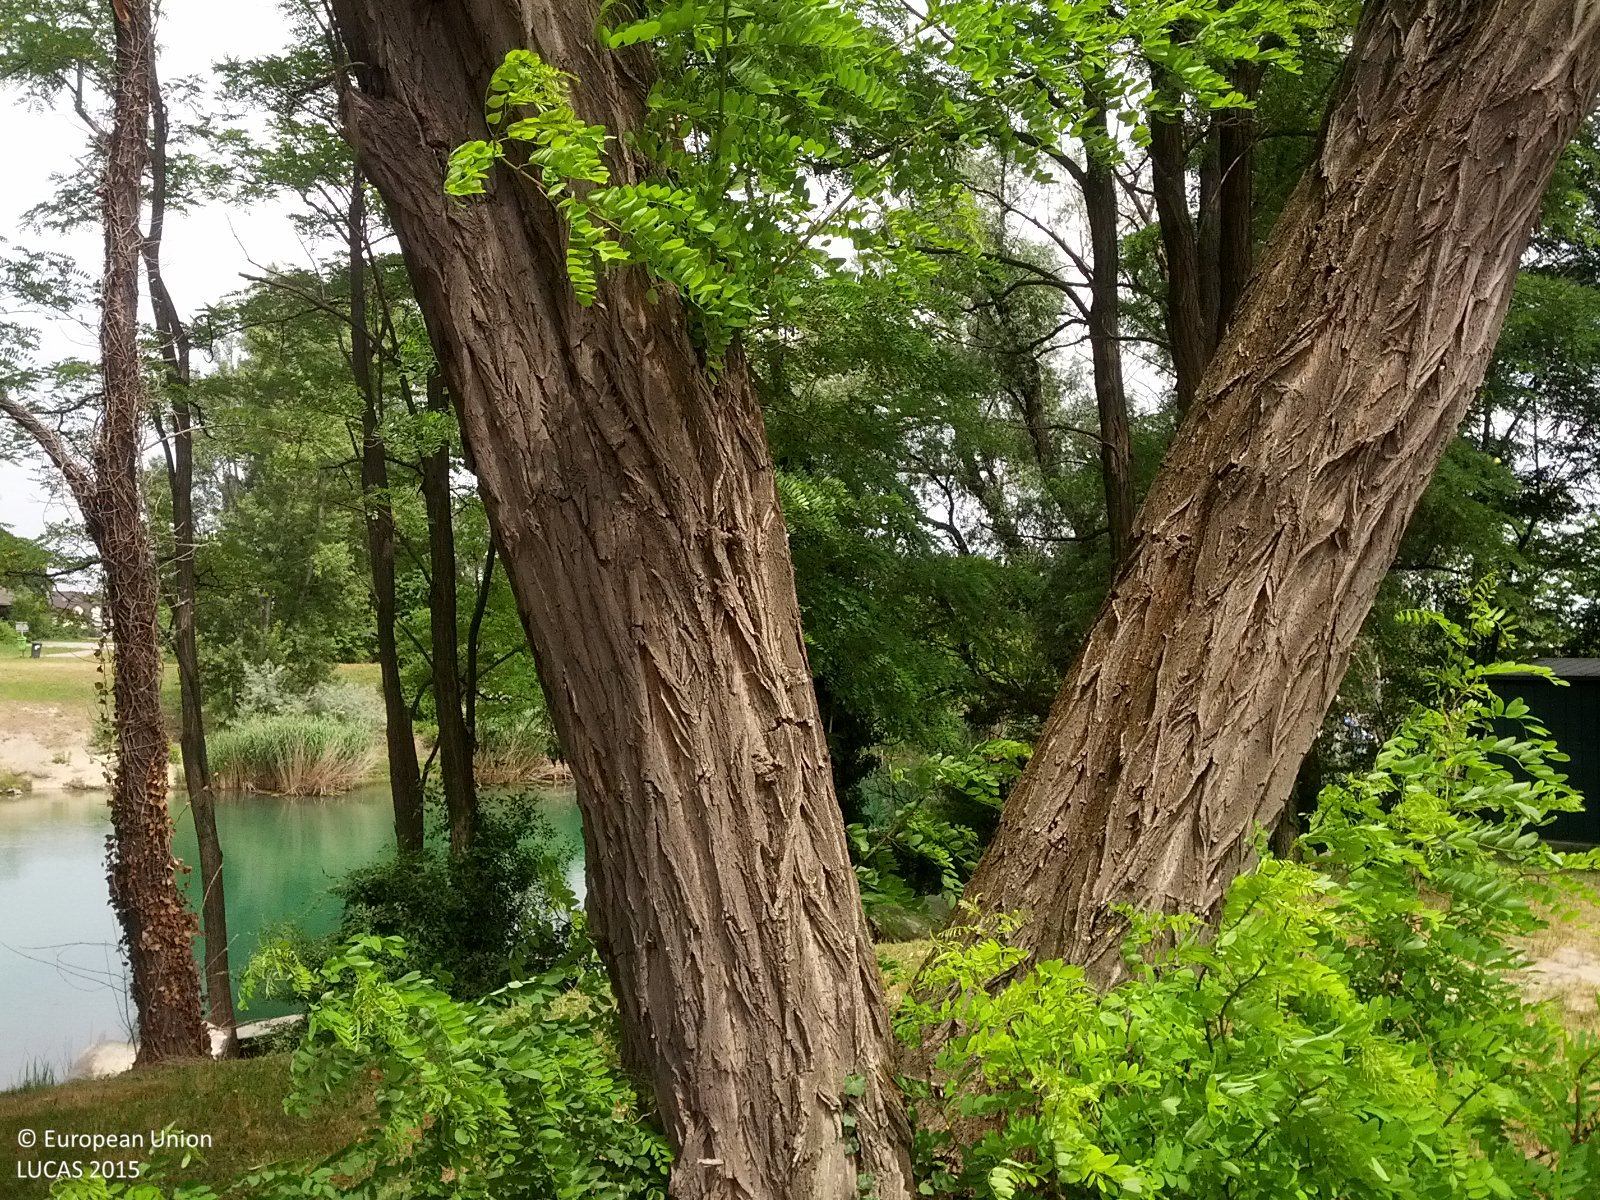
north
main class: Woodland
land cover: Broadleaved woodland
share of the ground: 25 - 50 %
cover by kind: herbaceous plants 60 %, broadleaved forest trees 35 %, shrubs 5 %
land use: Amenities, museums, leisure
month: June
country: AT
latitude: 48.1908
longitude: 16.5569
